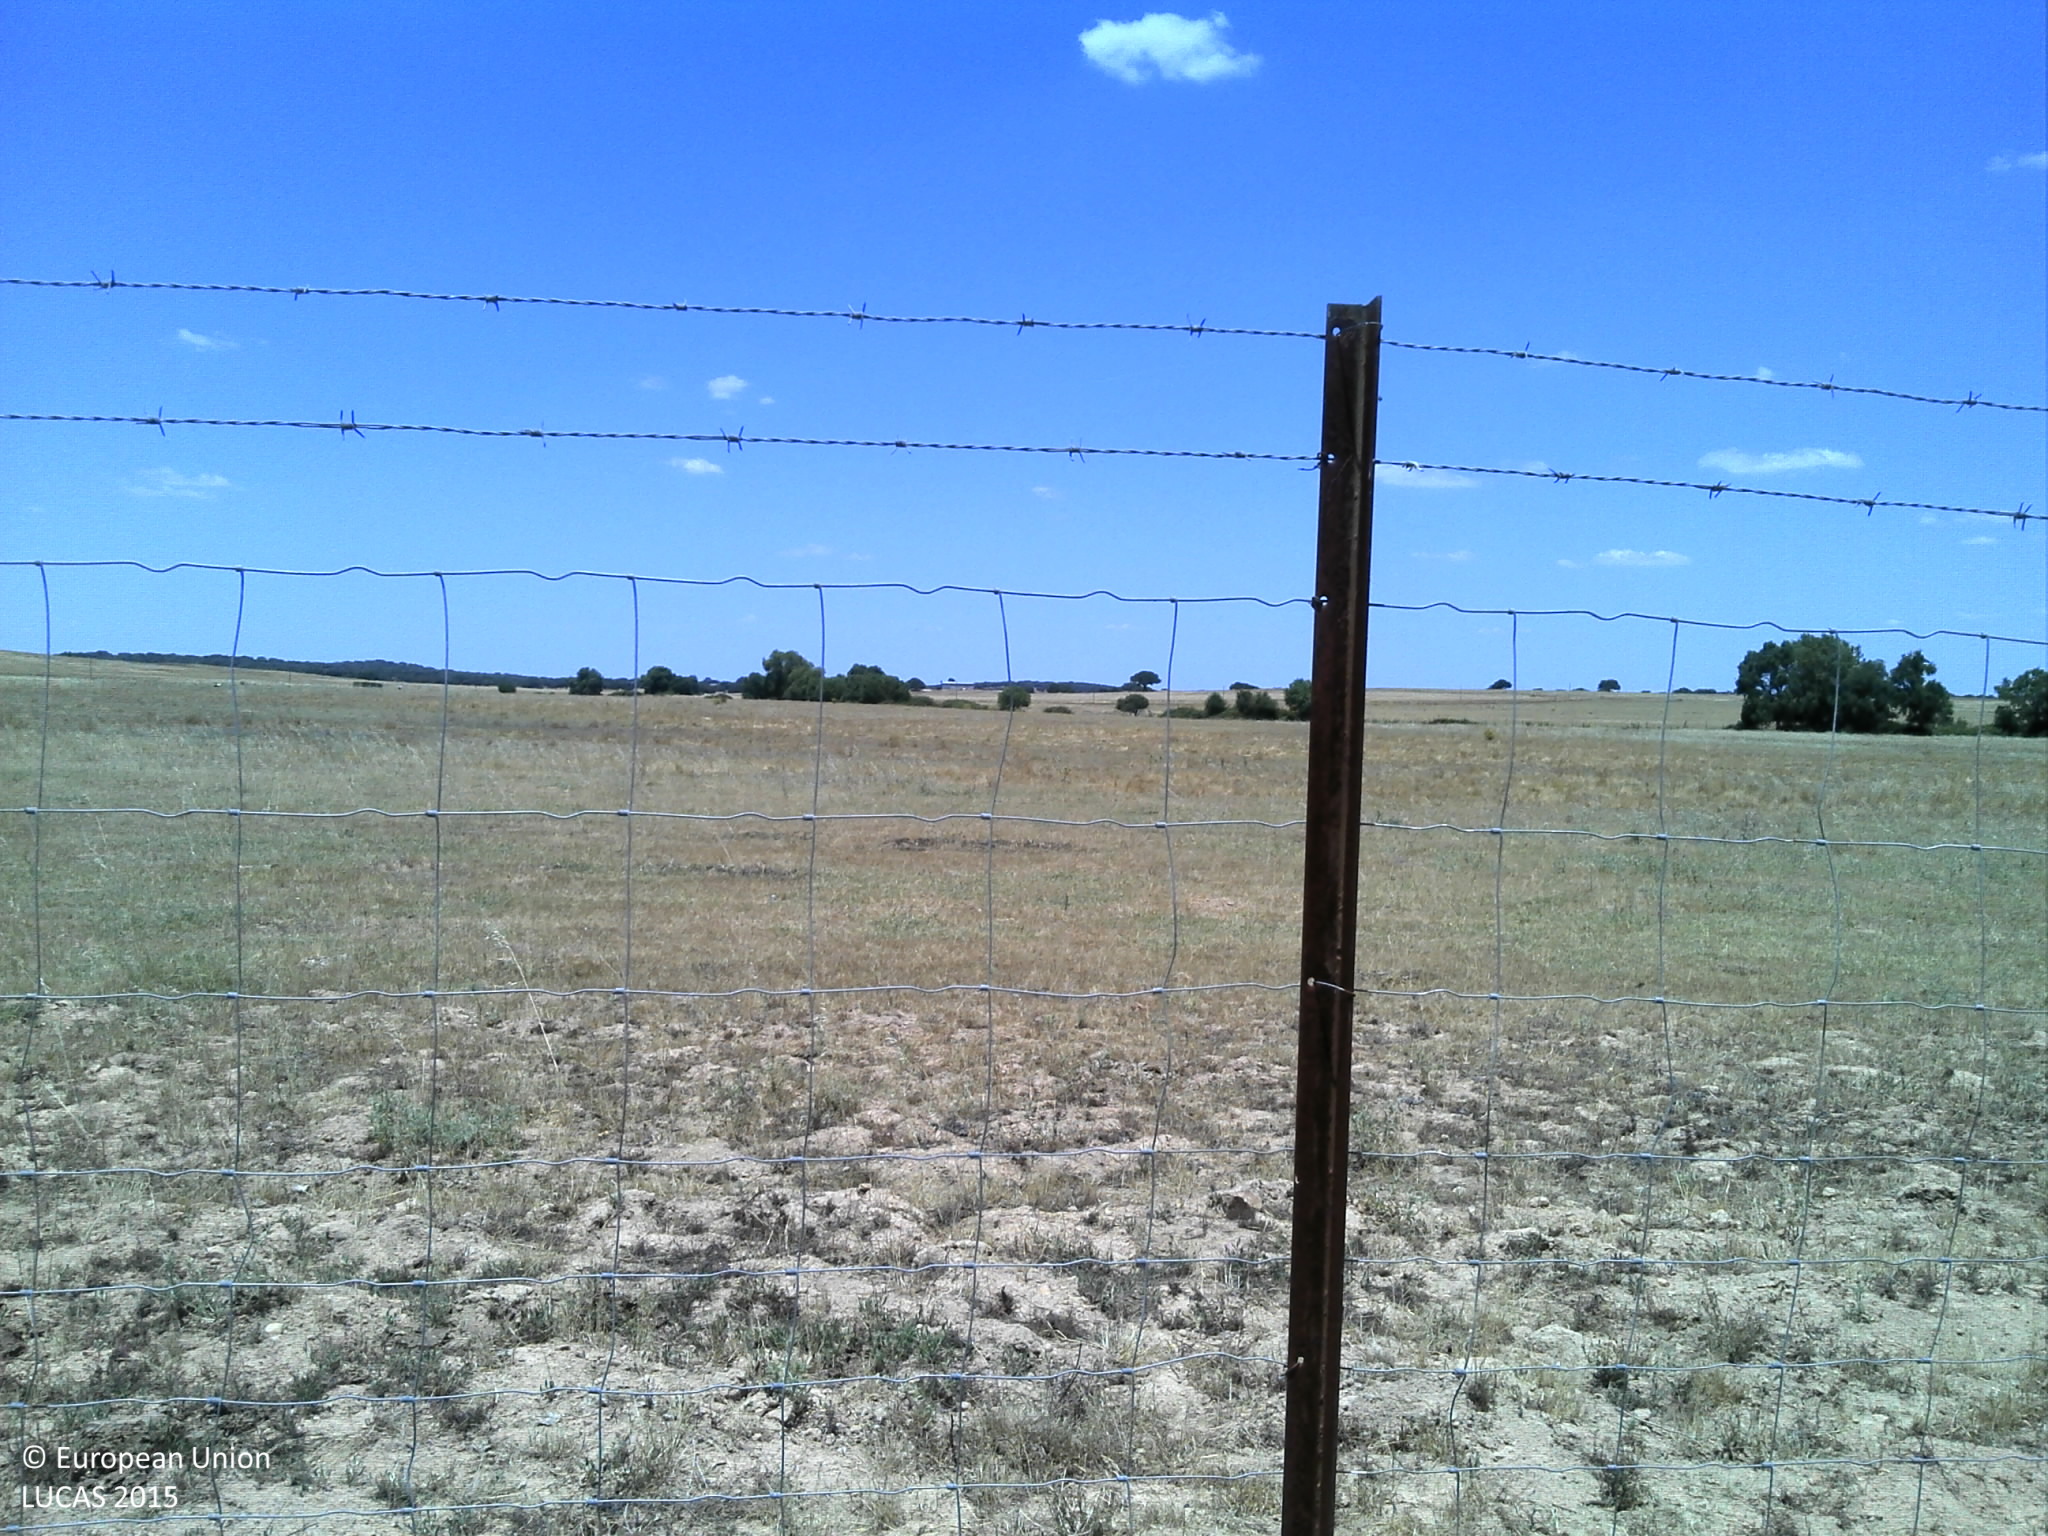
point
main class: Grassland
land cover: Grassland without tree/shrub cover
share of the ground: 10 - 25 %
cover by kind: unconsolidated bare surface 90 %, herbaceous plants 10 %
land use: Agriculture (excluding fallow land and kitchen gardens)
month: June
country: PT
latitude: 38.3665
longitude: -8.0892
